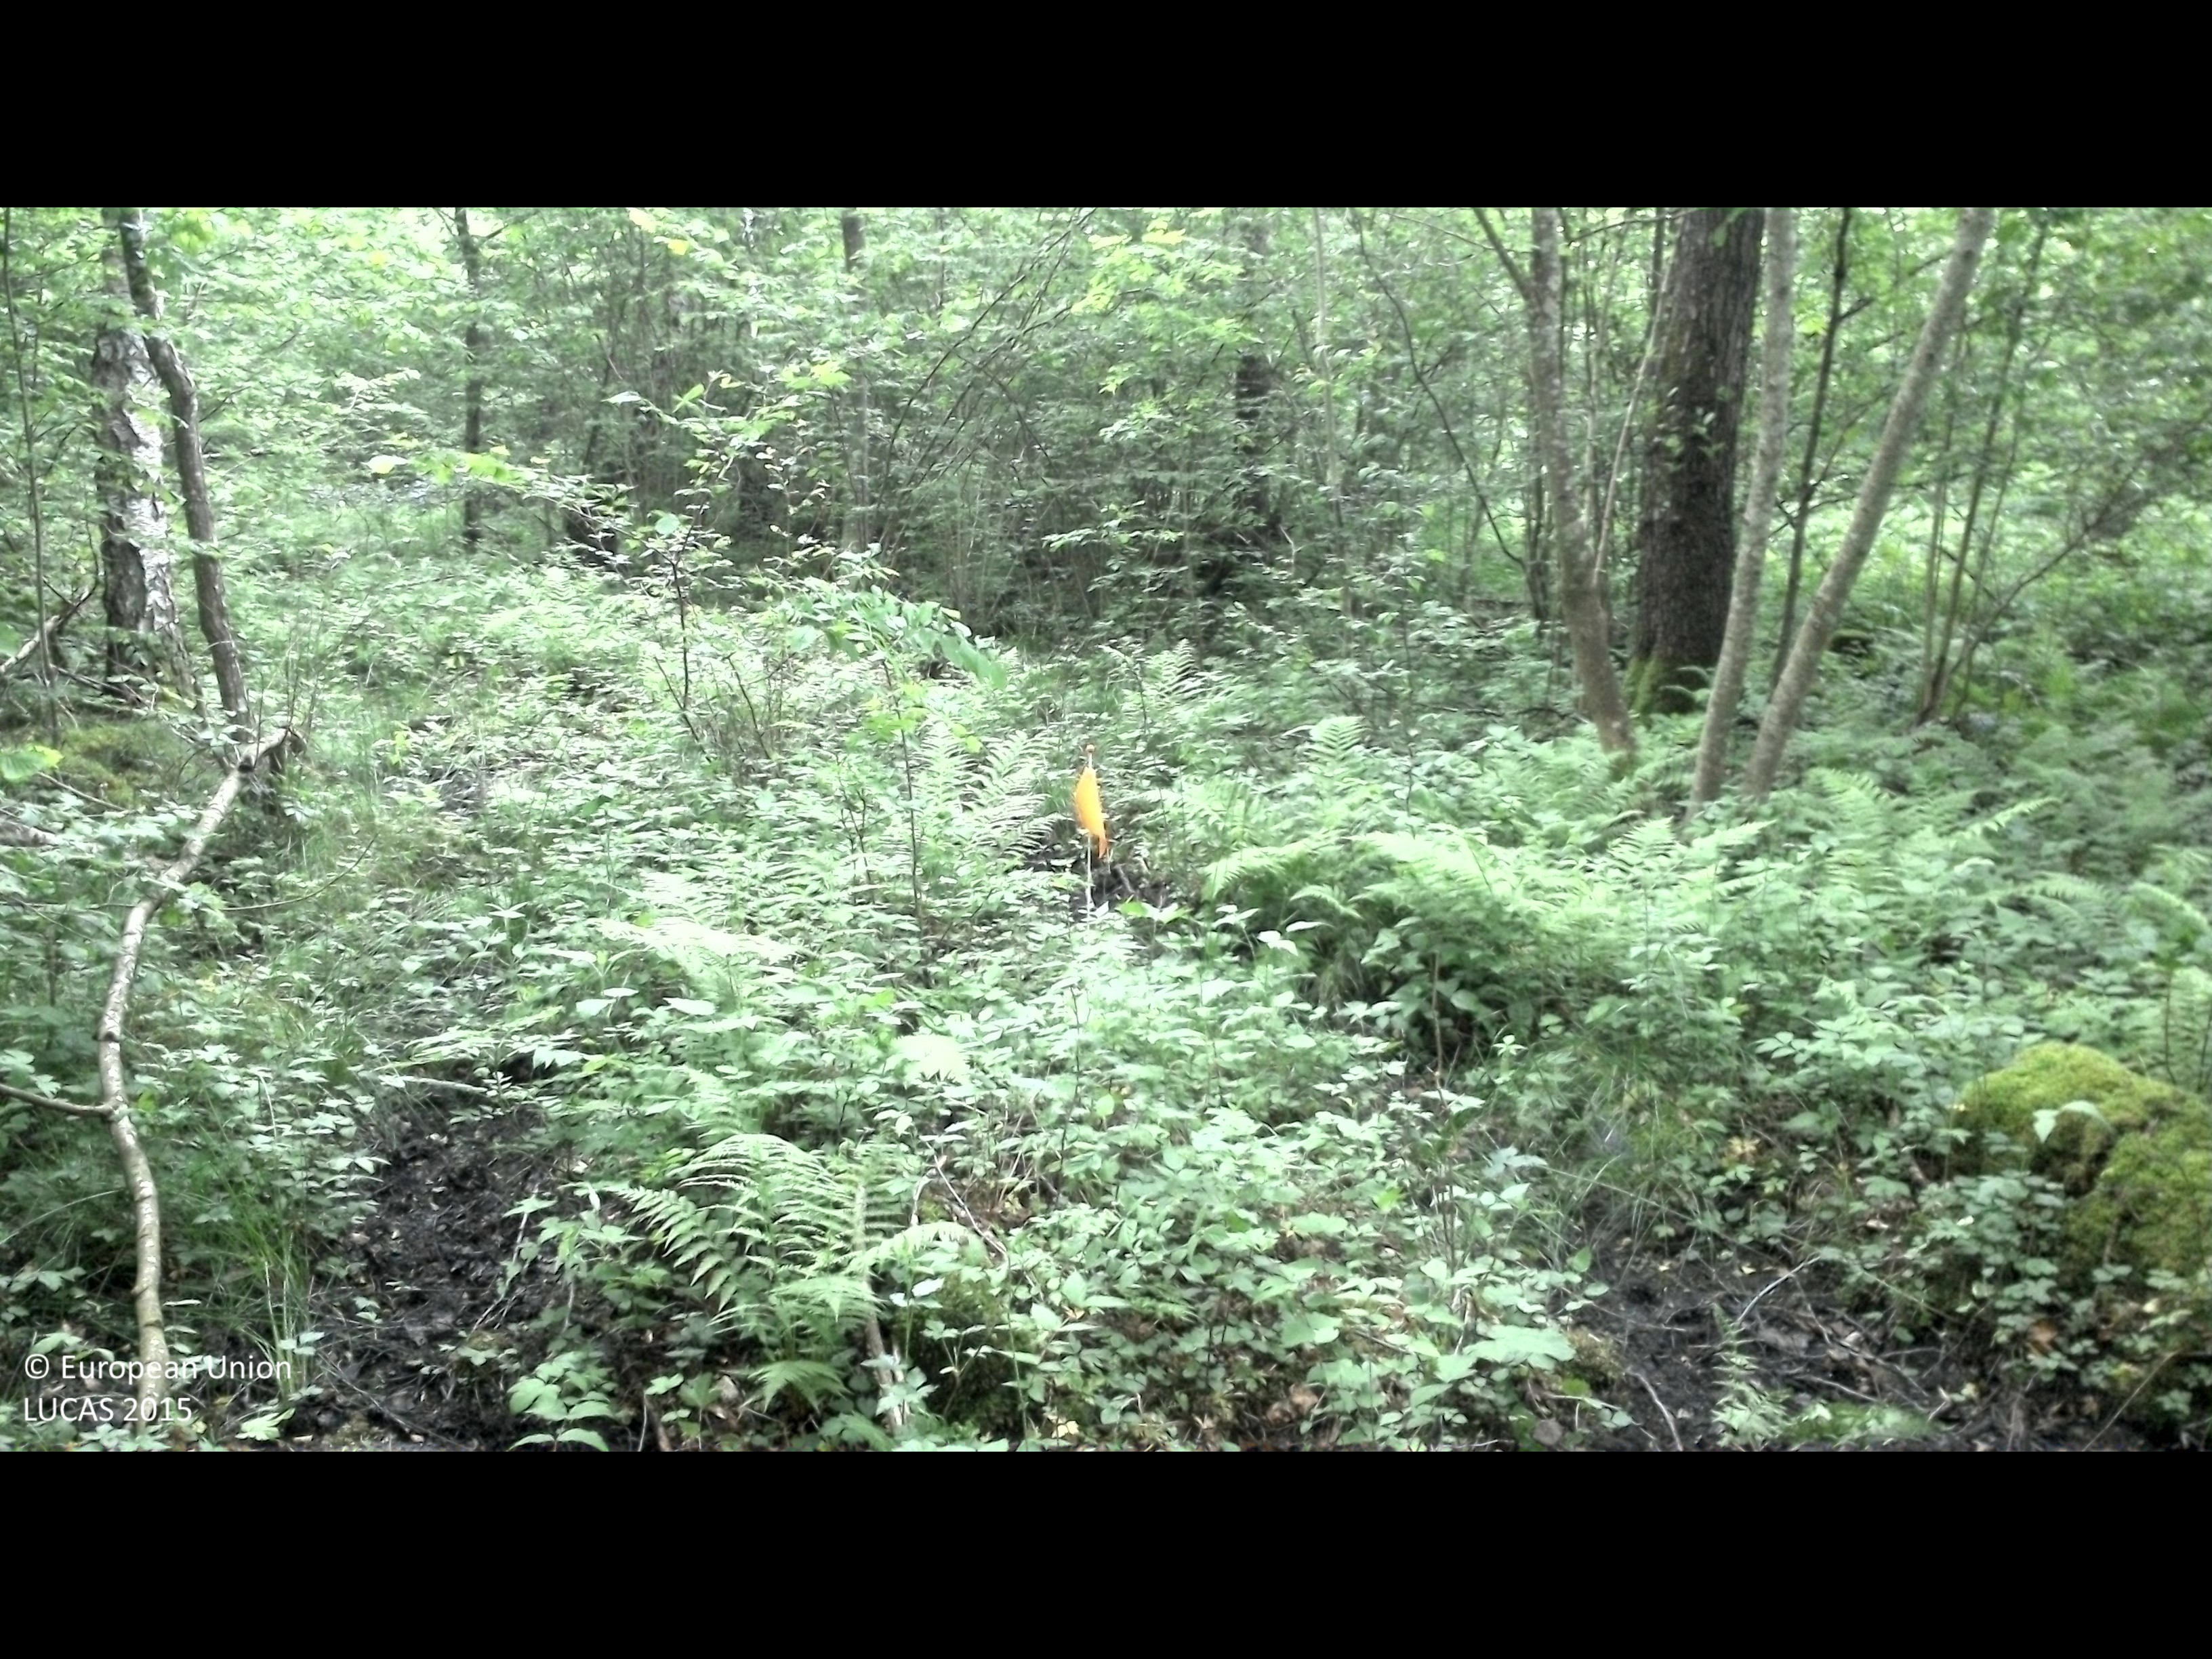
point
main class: Woodland
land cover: Broadleaved woodland
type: hemiboreal forest and nemoral coniferous forest and mixed broadleaved-coniferous forest
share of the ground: 50 - 75 %
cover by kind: broadleaved forest trees 65 %, shrubs 30 %, herbaceous plants 5 %
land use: Forestry
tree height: > 5 m
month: June
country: SE
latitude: 56.1782
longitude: 14.0410
